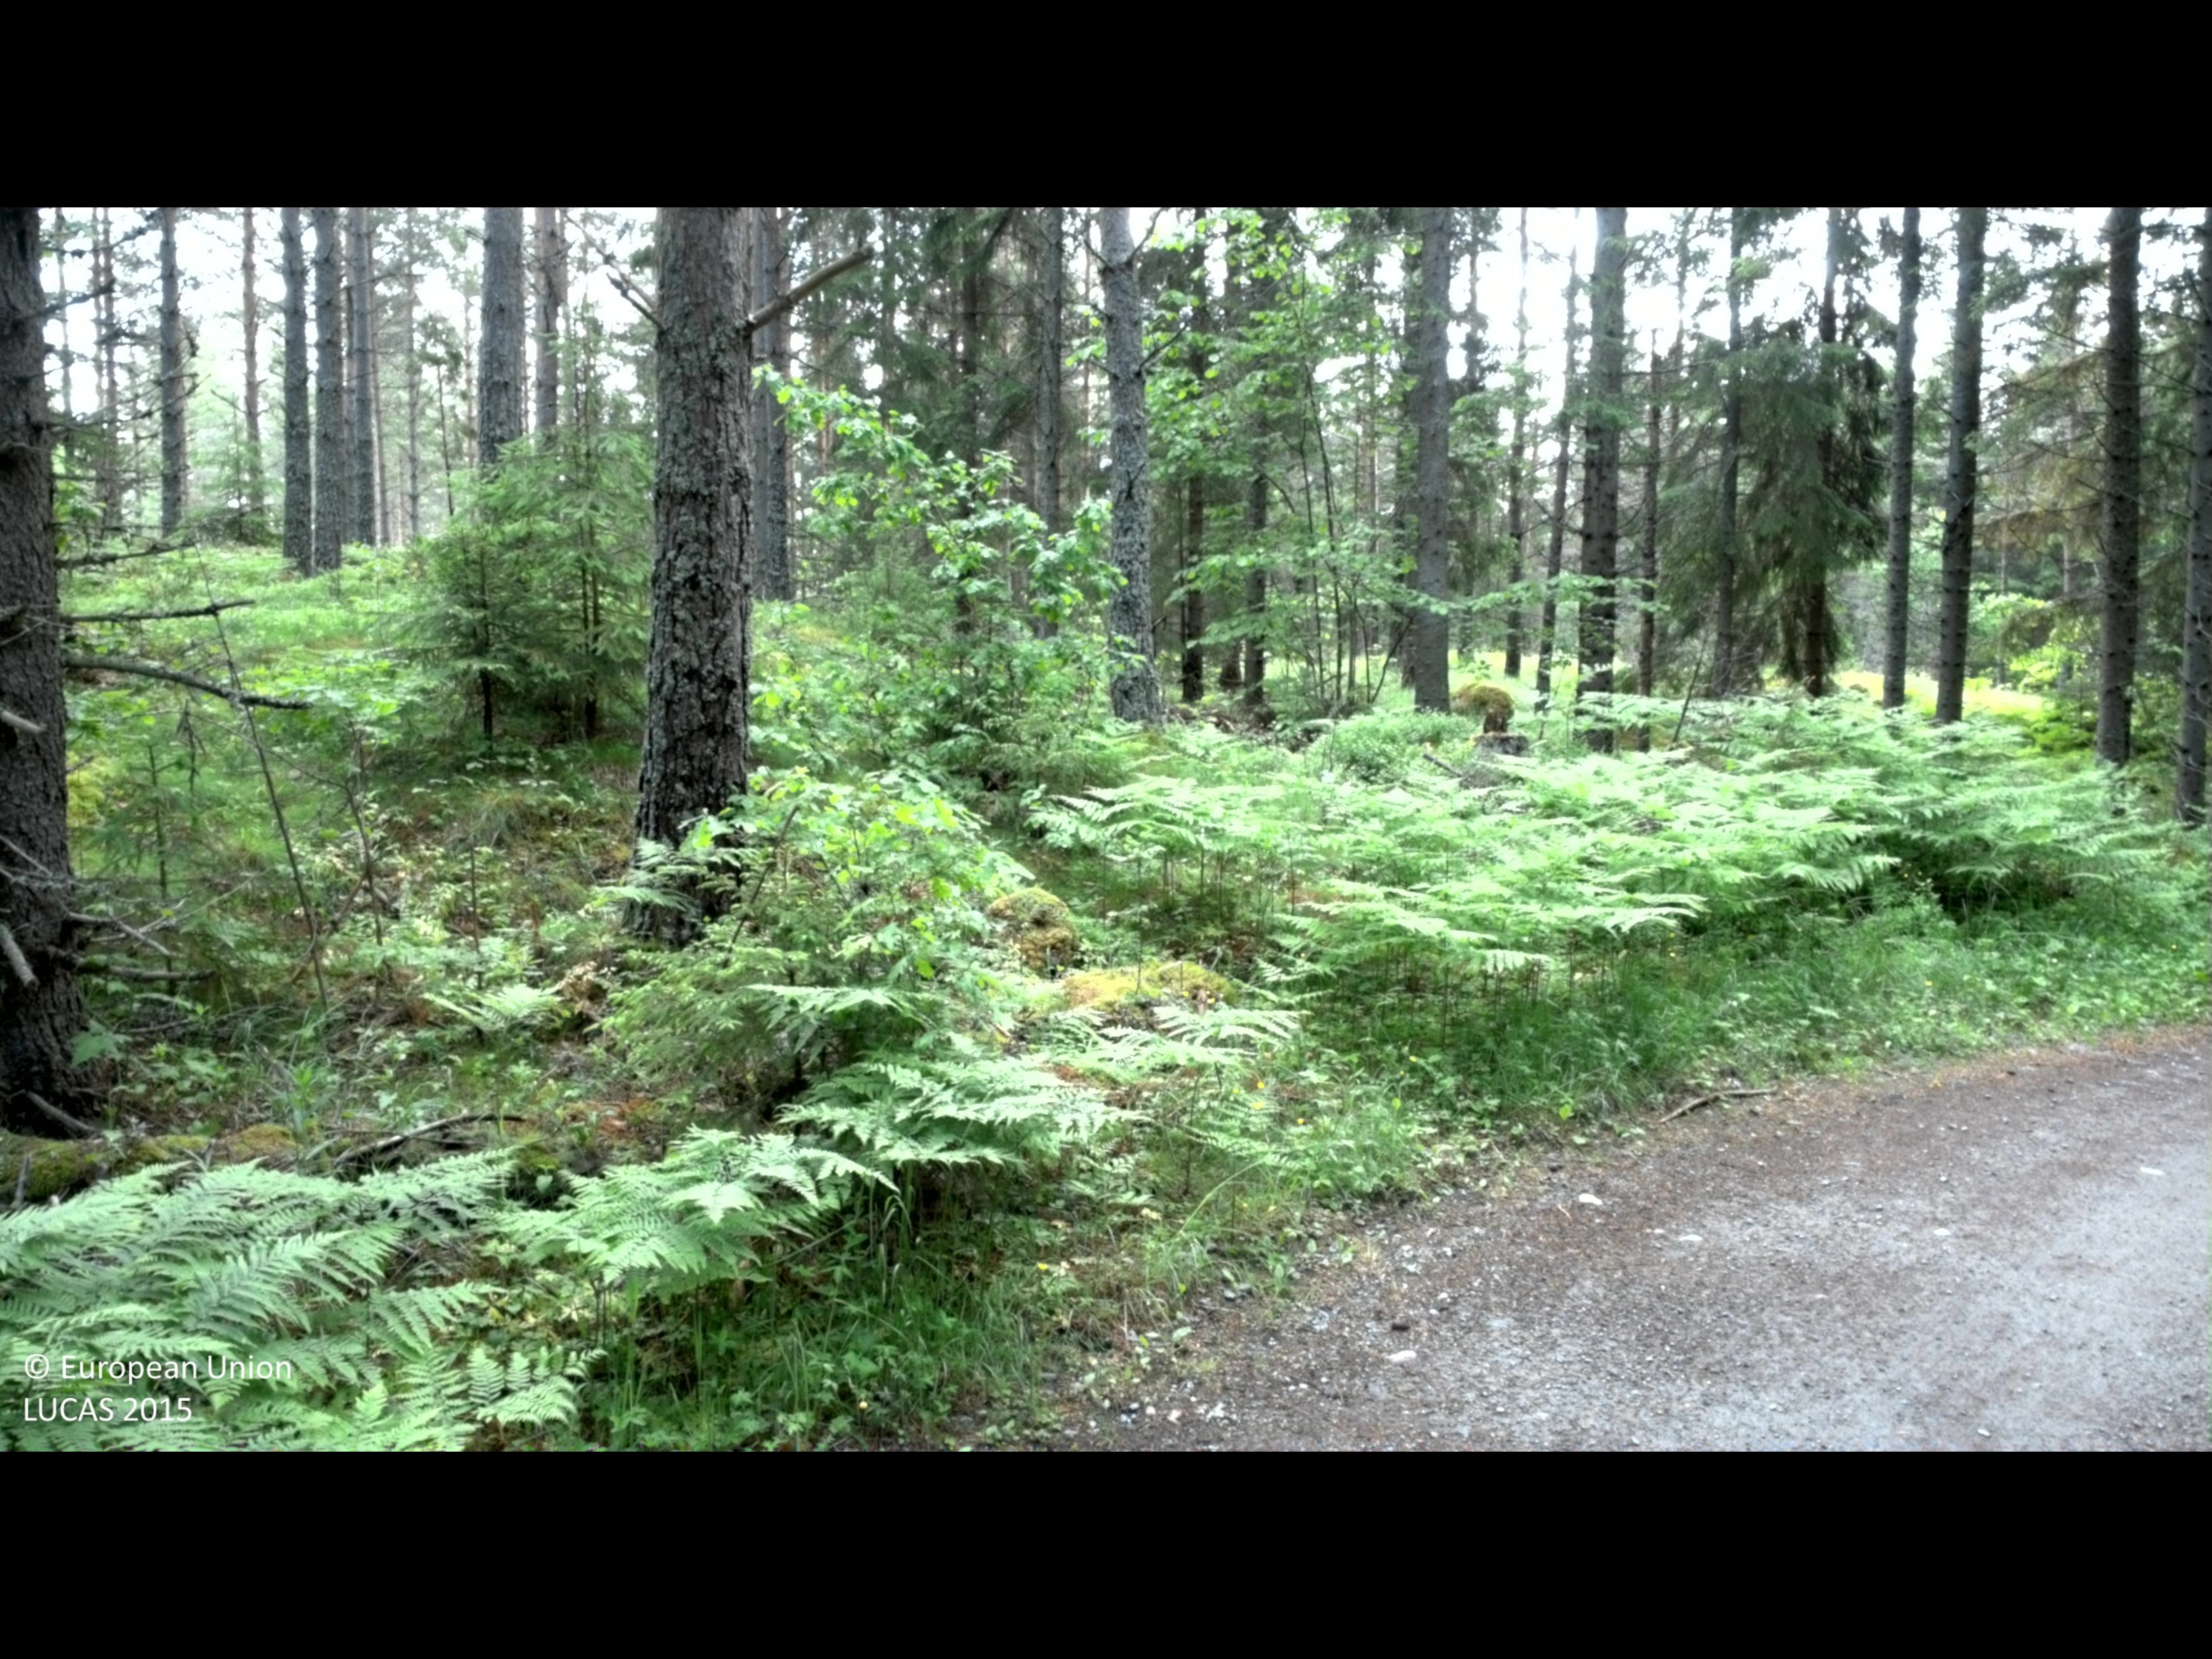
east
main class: Woodland
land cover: Spruce dominated coniferous woodland
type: boreal forest
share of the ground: > 75 %
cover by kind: coniferous forest trees 75 %, shrubs 10 %, lichens and mosses 10 %, broadleaved forest trees 5 %
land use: Forestry
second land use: Sport
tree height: > 5 m
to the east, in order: Paved roads, cycling and walking lanes; Spruce dominated coniferous woodland
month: June
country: SE
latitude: 58.0818
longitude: 16.0843
